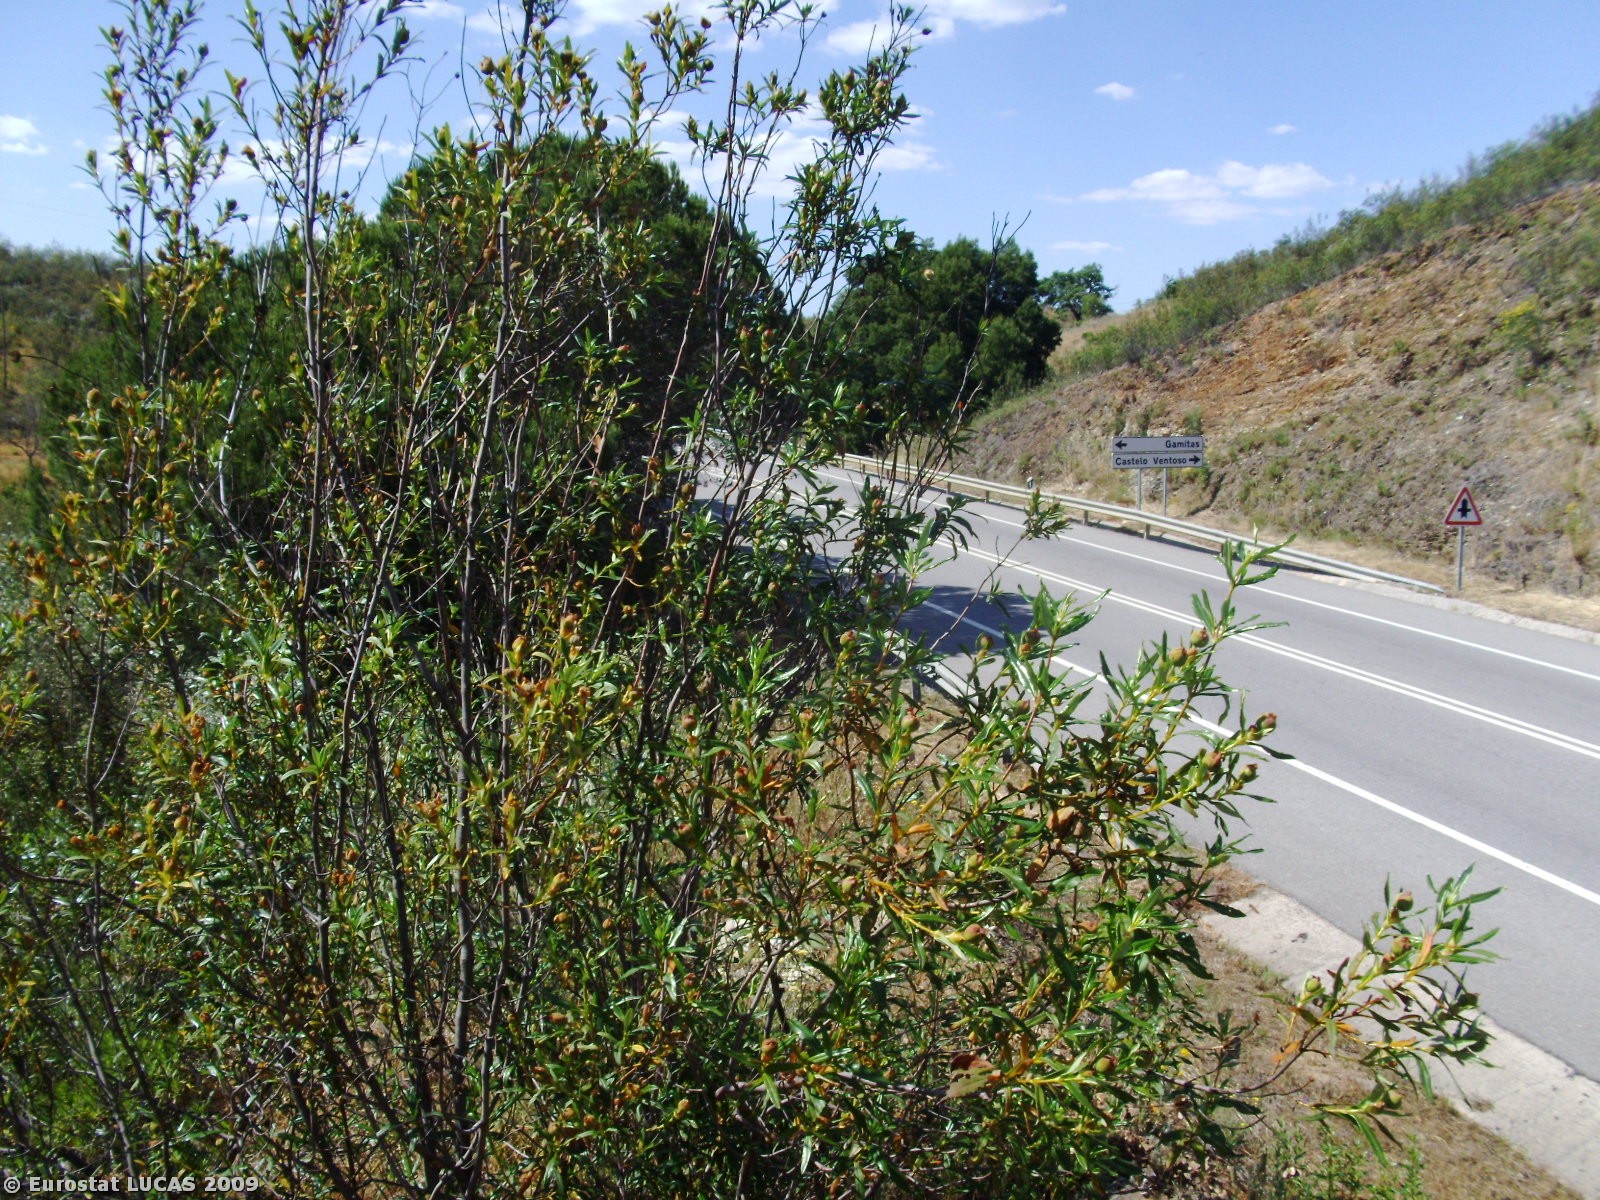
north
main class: Shrubland
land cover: Shrubland without tree cover
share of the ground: > 75 %
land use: Unused
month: May
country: PT
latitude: 37.4723
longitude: -8.3112
